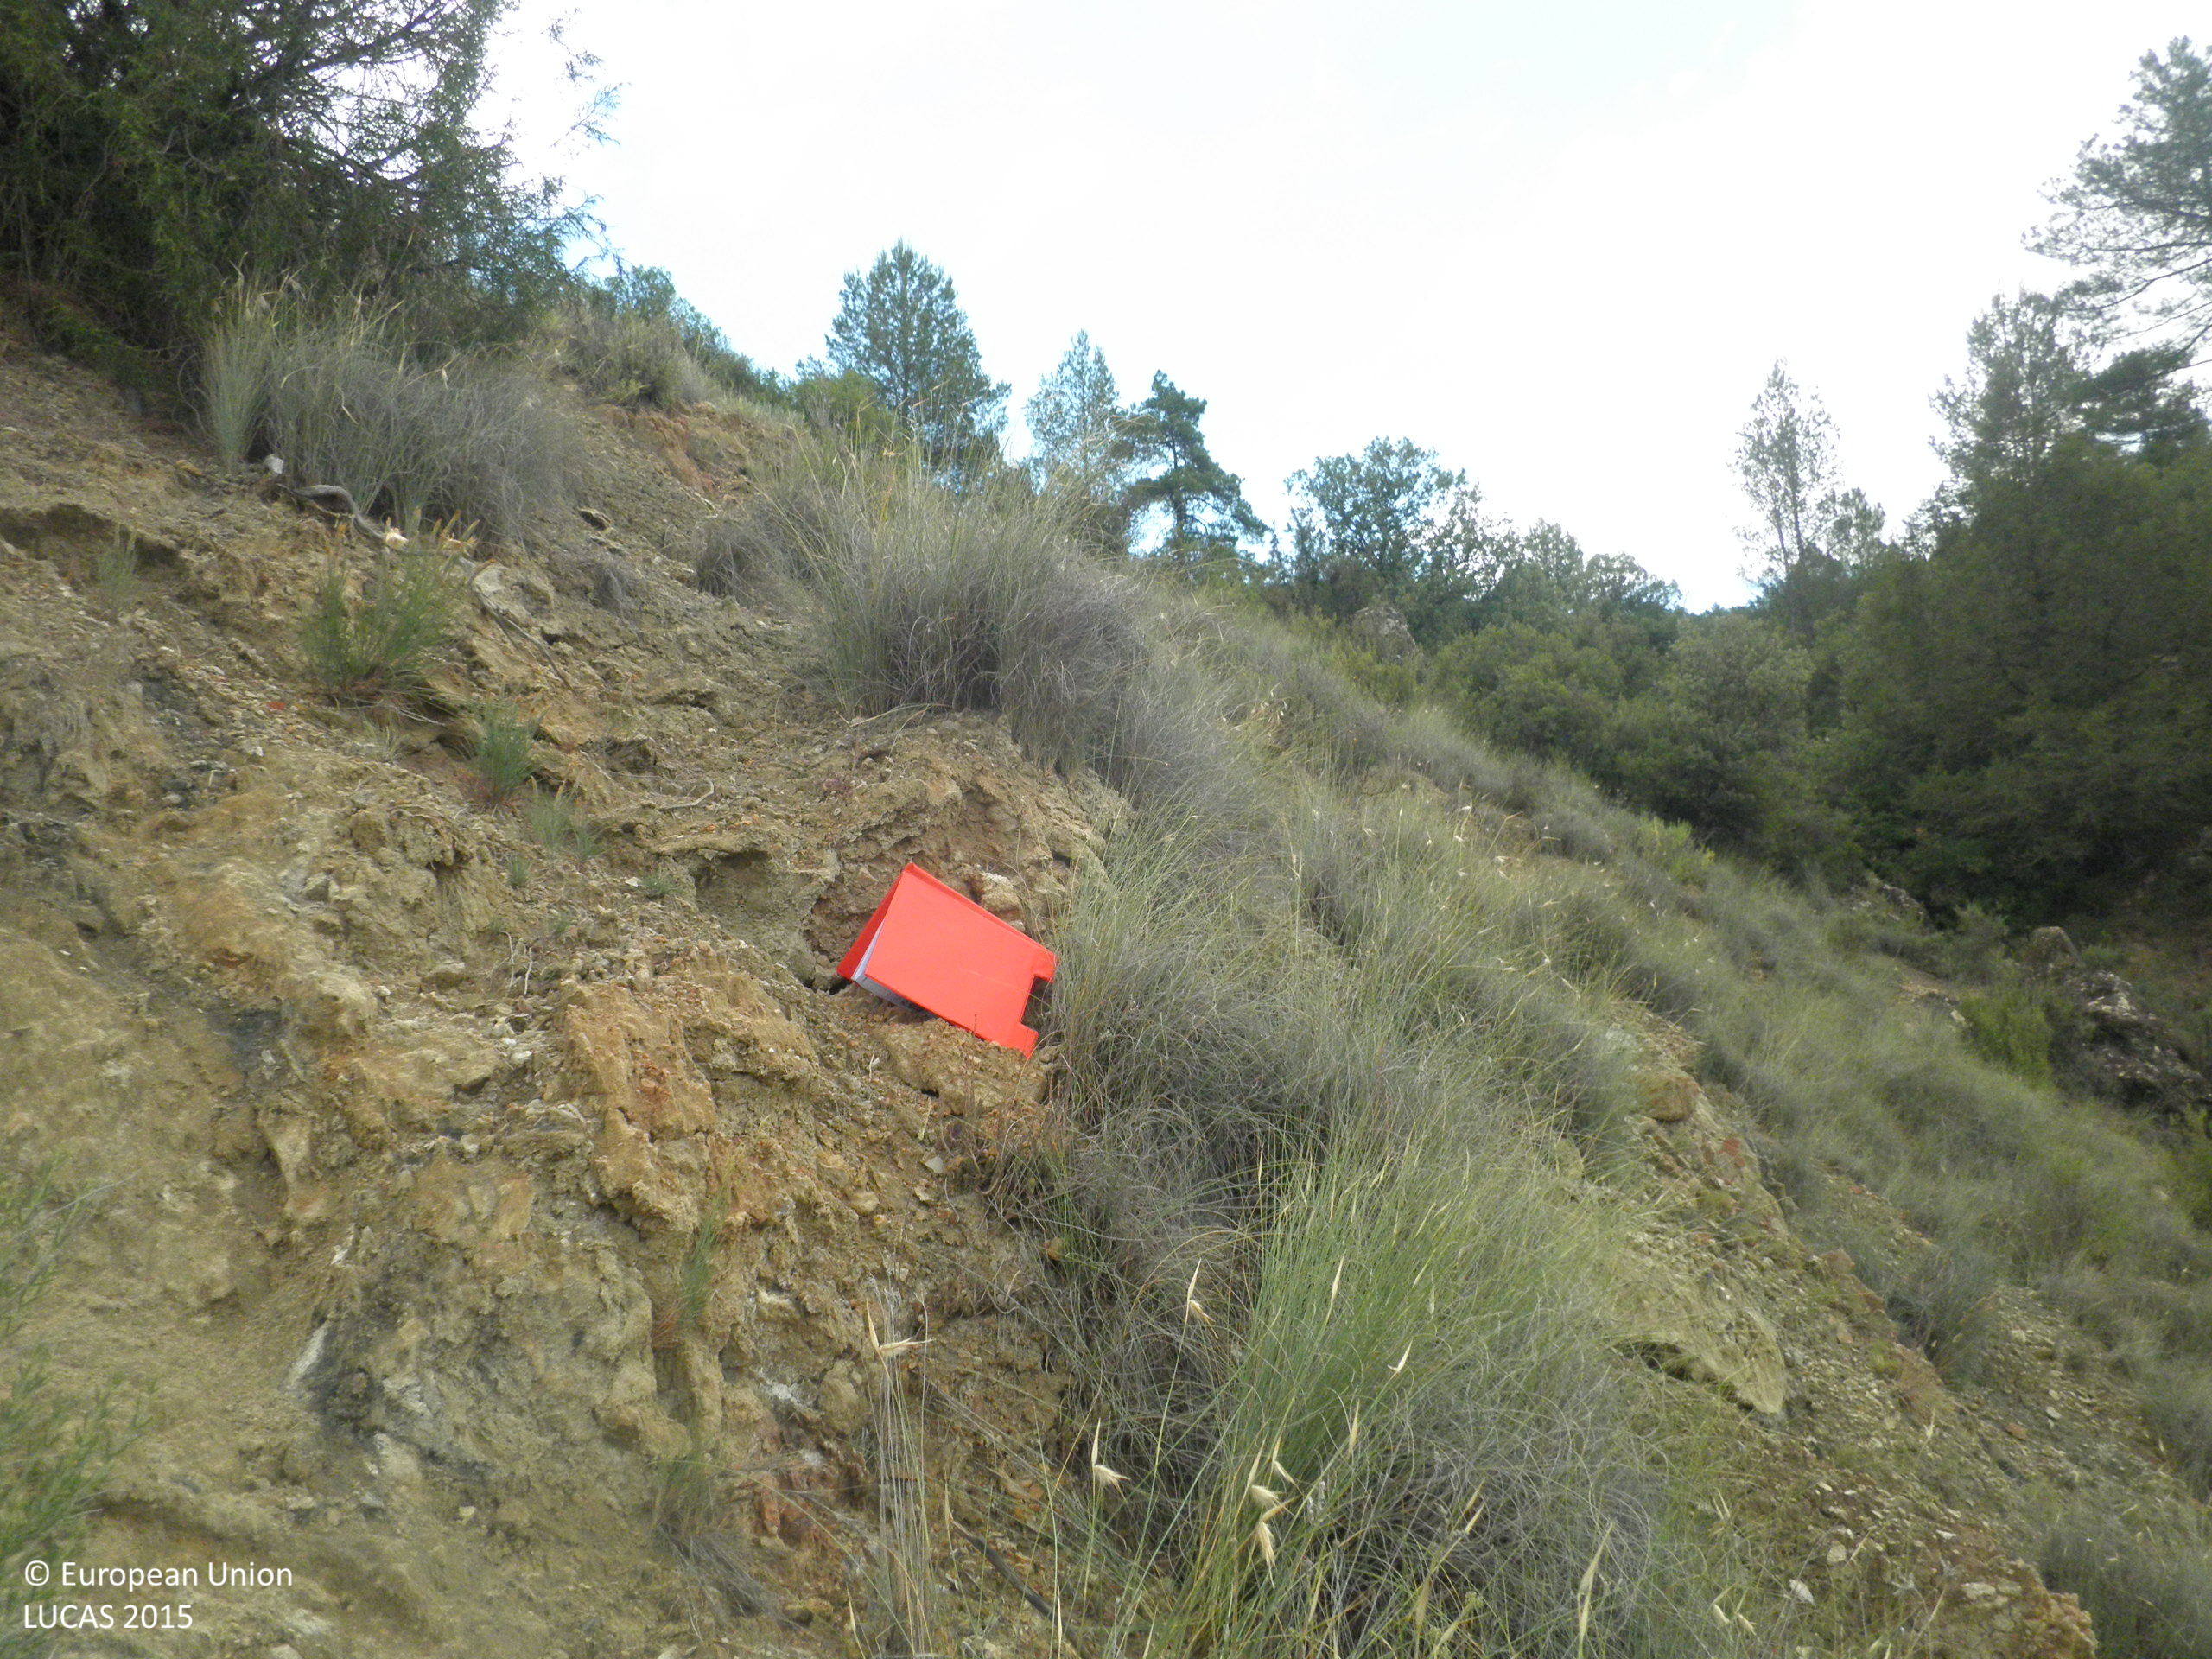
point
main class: Shrubland
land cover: Shrubland without tree cover
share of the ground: 10 - 25 %
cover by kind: unconsolidated bare surface 80 %, shrubs 20 %
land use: Semi-natural and natural areas not in use
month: June
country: ES
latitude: 39.7445
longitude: -1.5722
